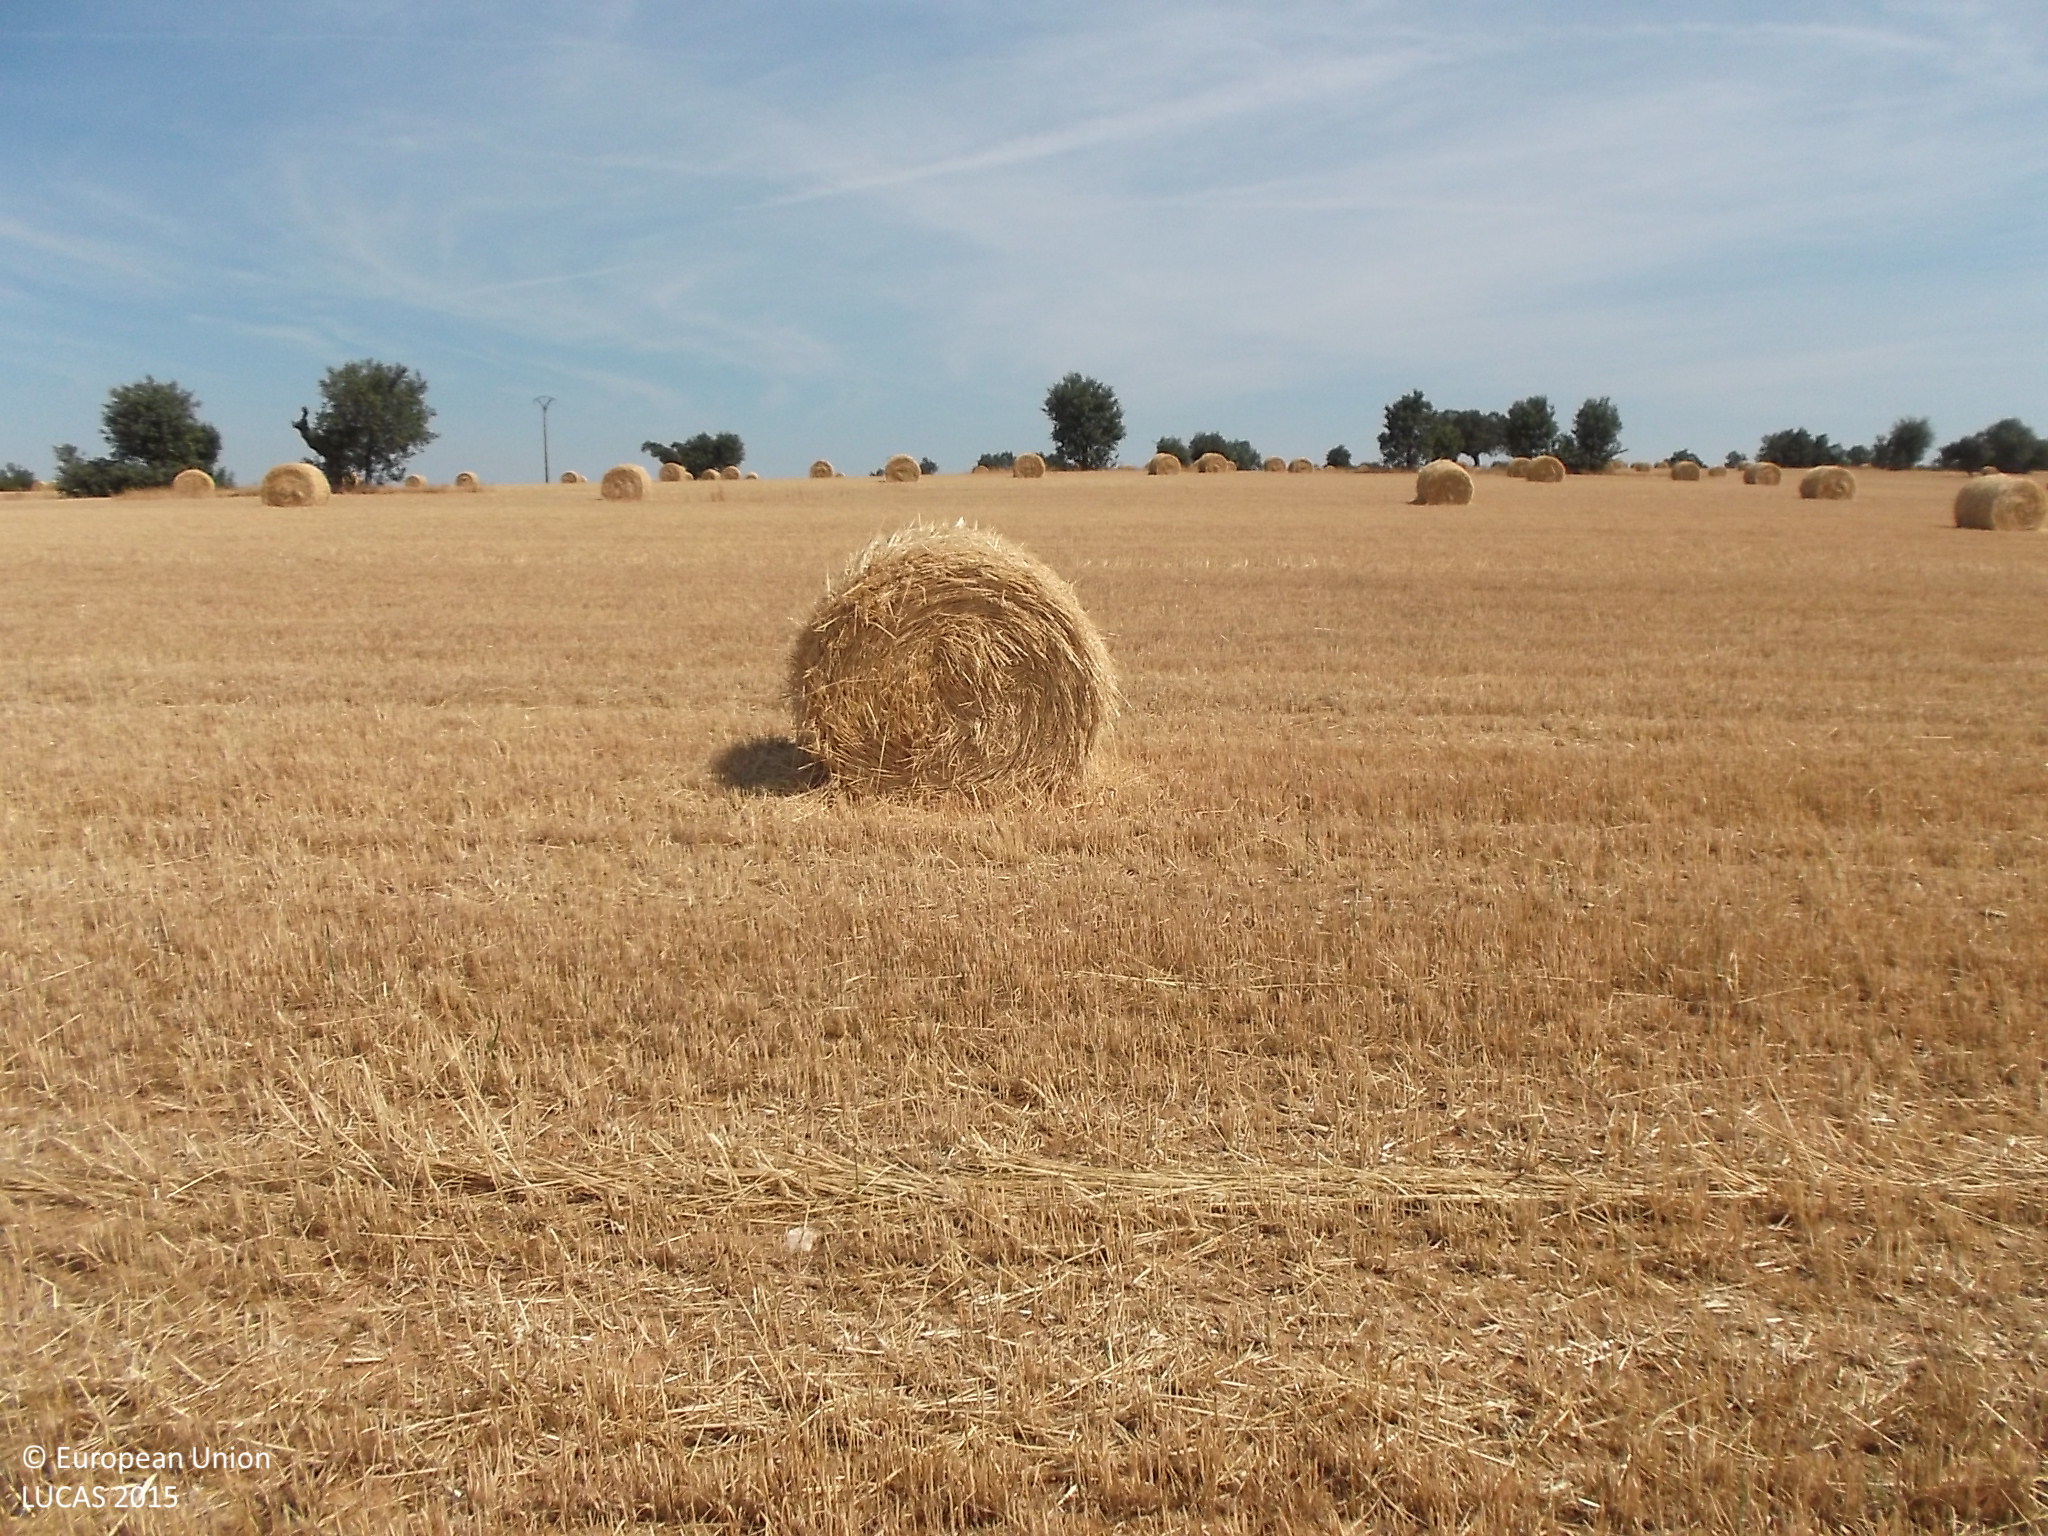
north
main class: Cropland
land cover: Mixed cereals for fodder
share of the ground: < 10 %
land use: Agriculture (excluding fallow land and kitchen gardens)
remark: Harvested field
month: June
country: ES
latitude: 41.2095
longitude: -5.9850
